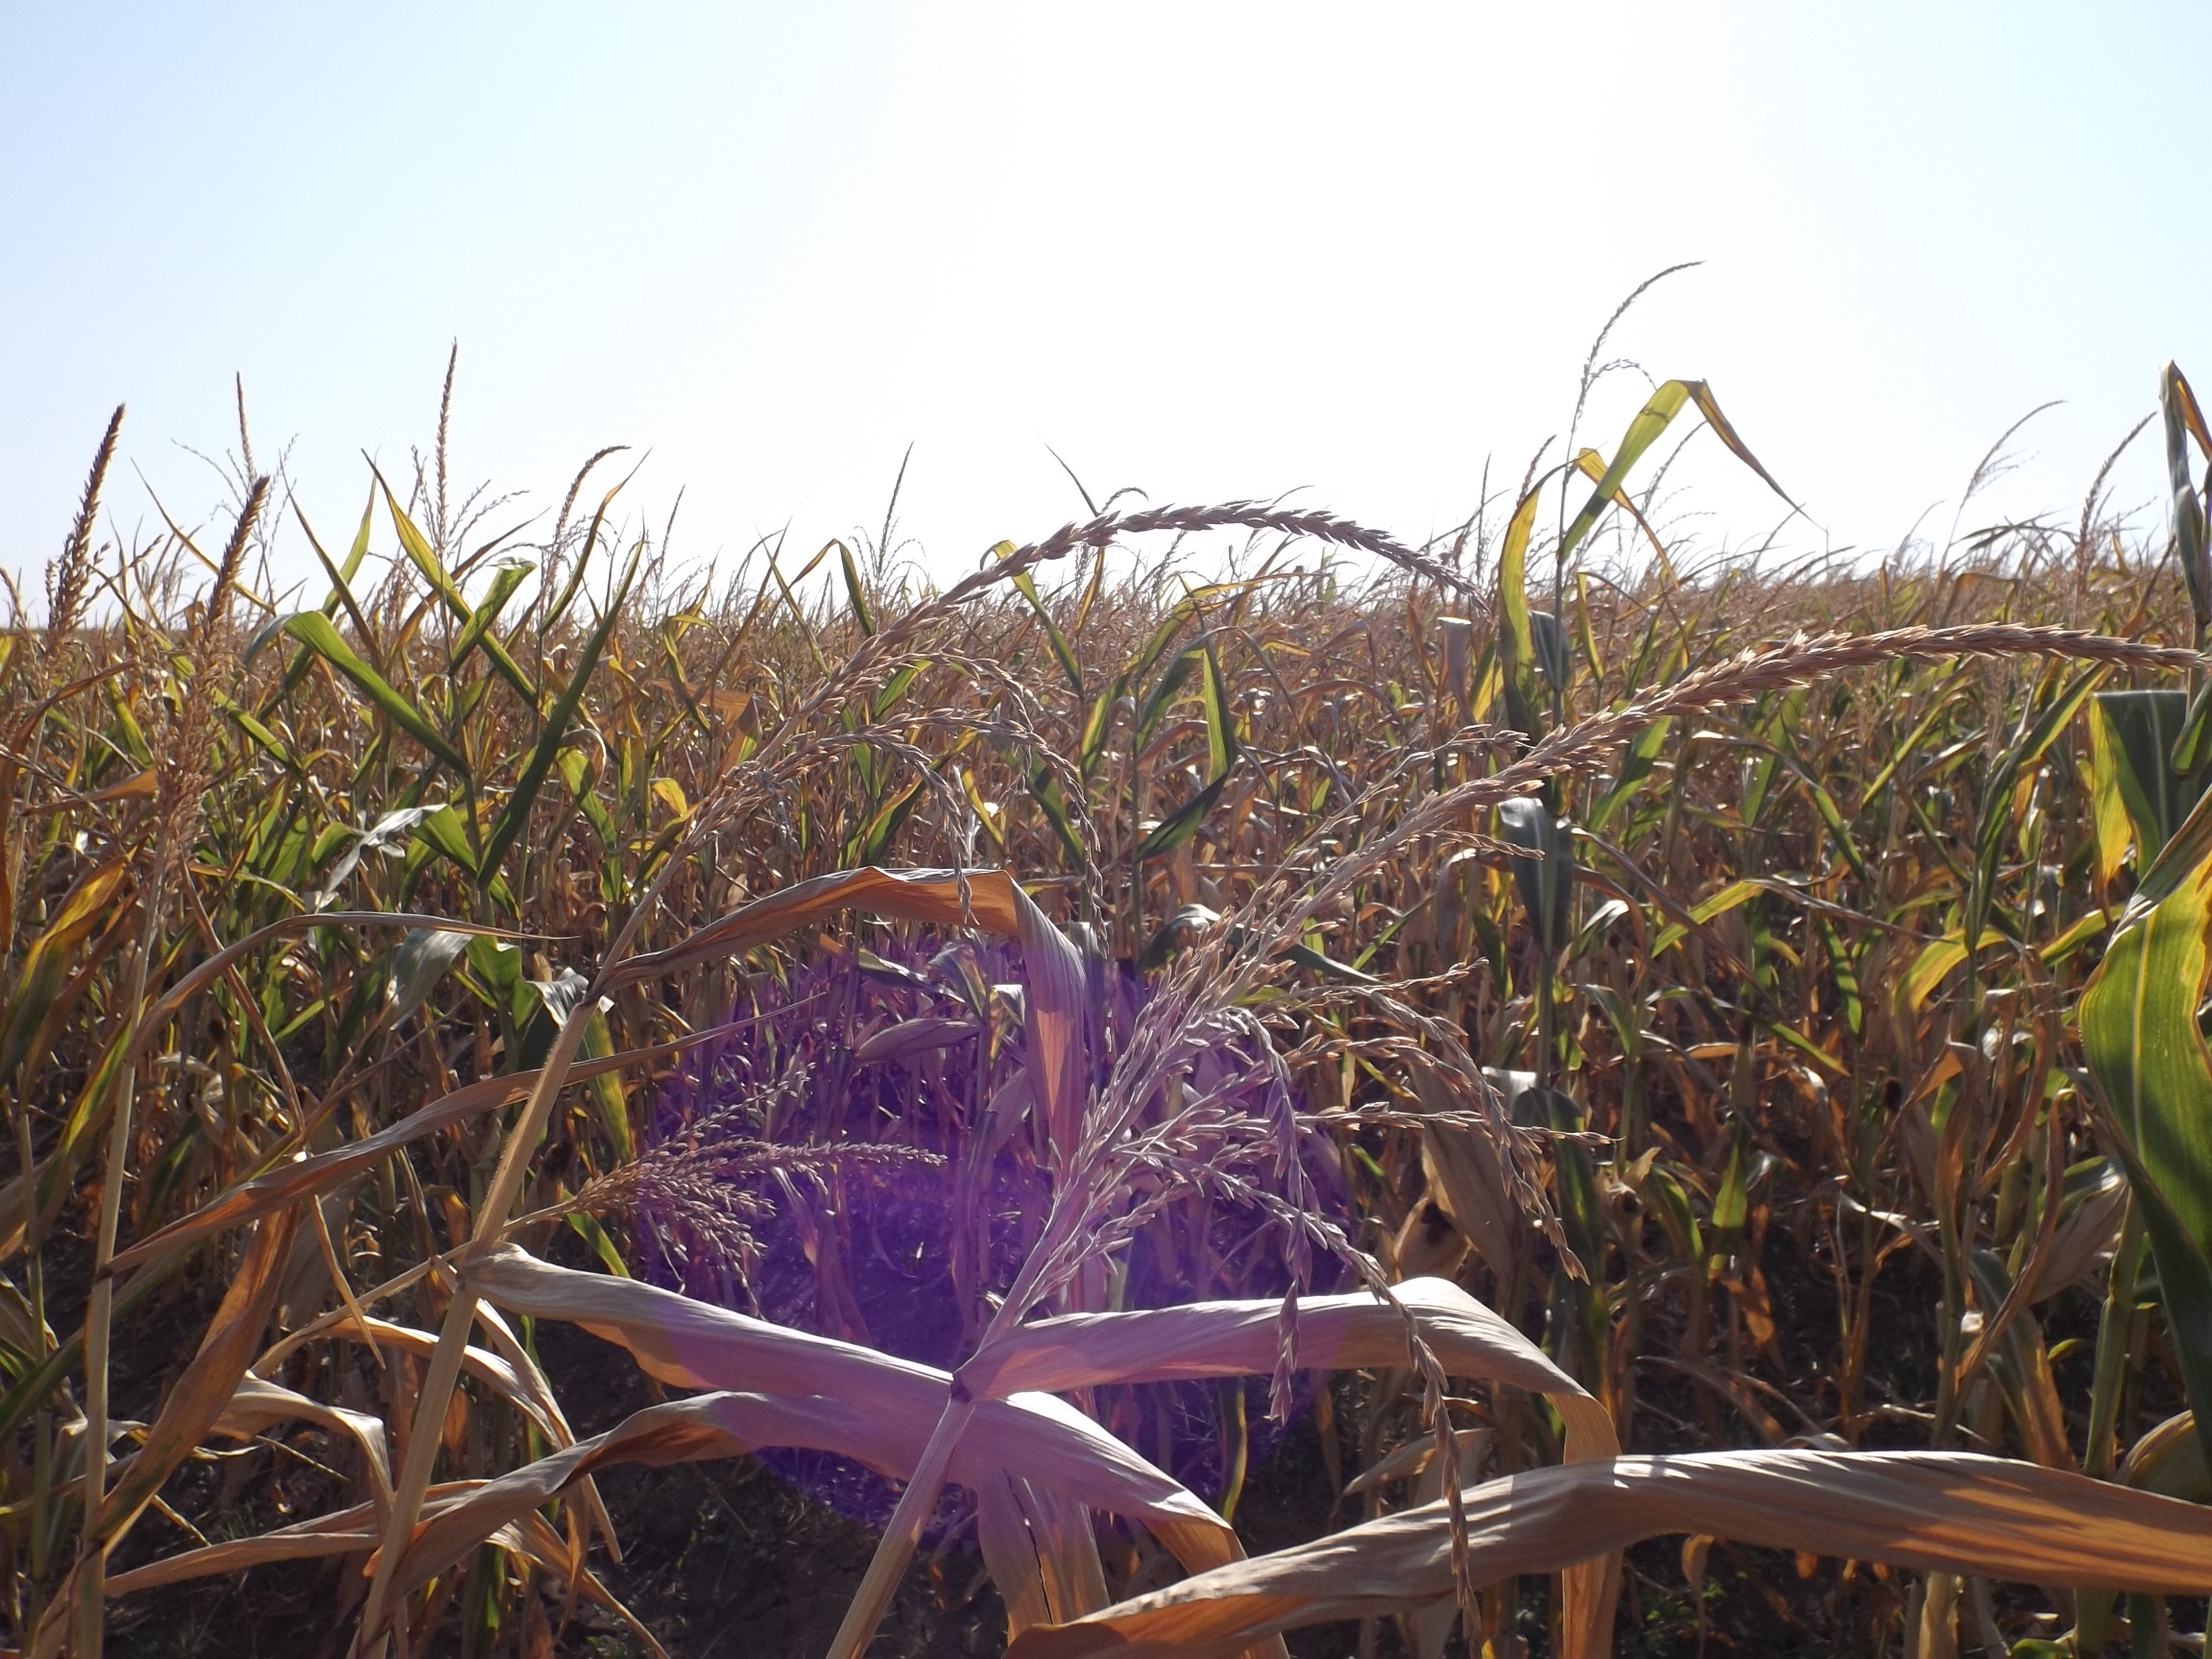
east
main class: Cropland
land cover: Maize
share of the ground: > 75 %
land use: Agriculture (excluding fallow land and kitchen gardens)
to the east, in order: Maize; Tracks; Grass margins; Common wheat
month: August
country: BG
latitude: 43.4672
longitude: 27.5483
